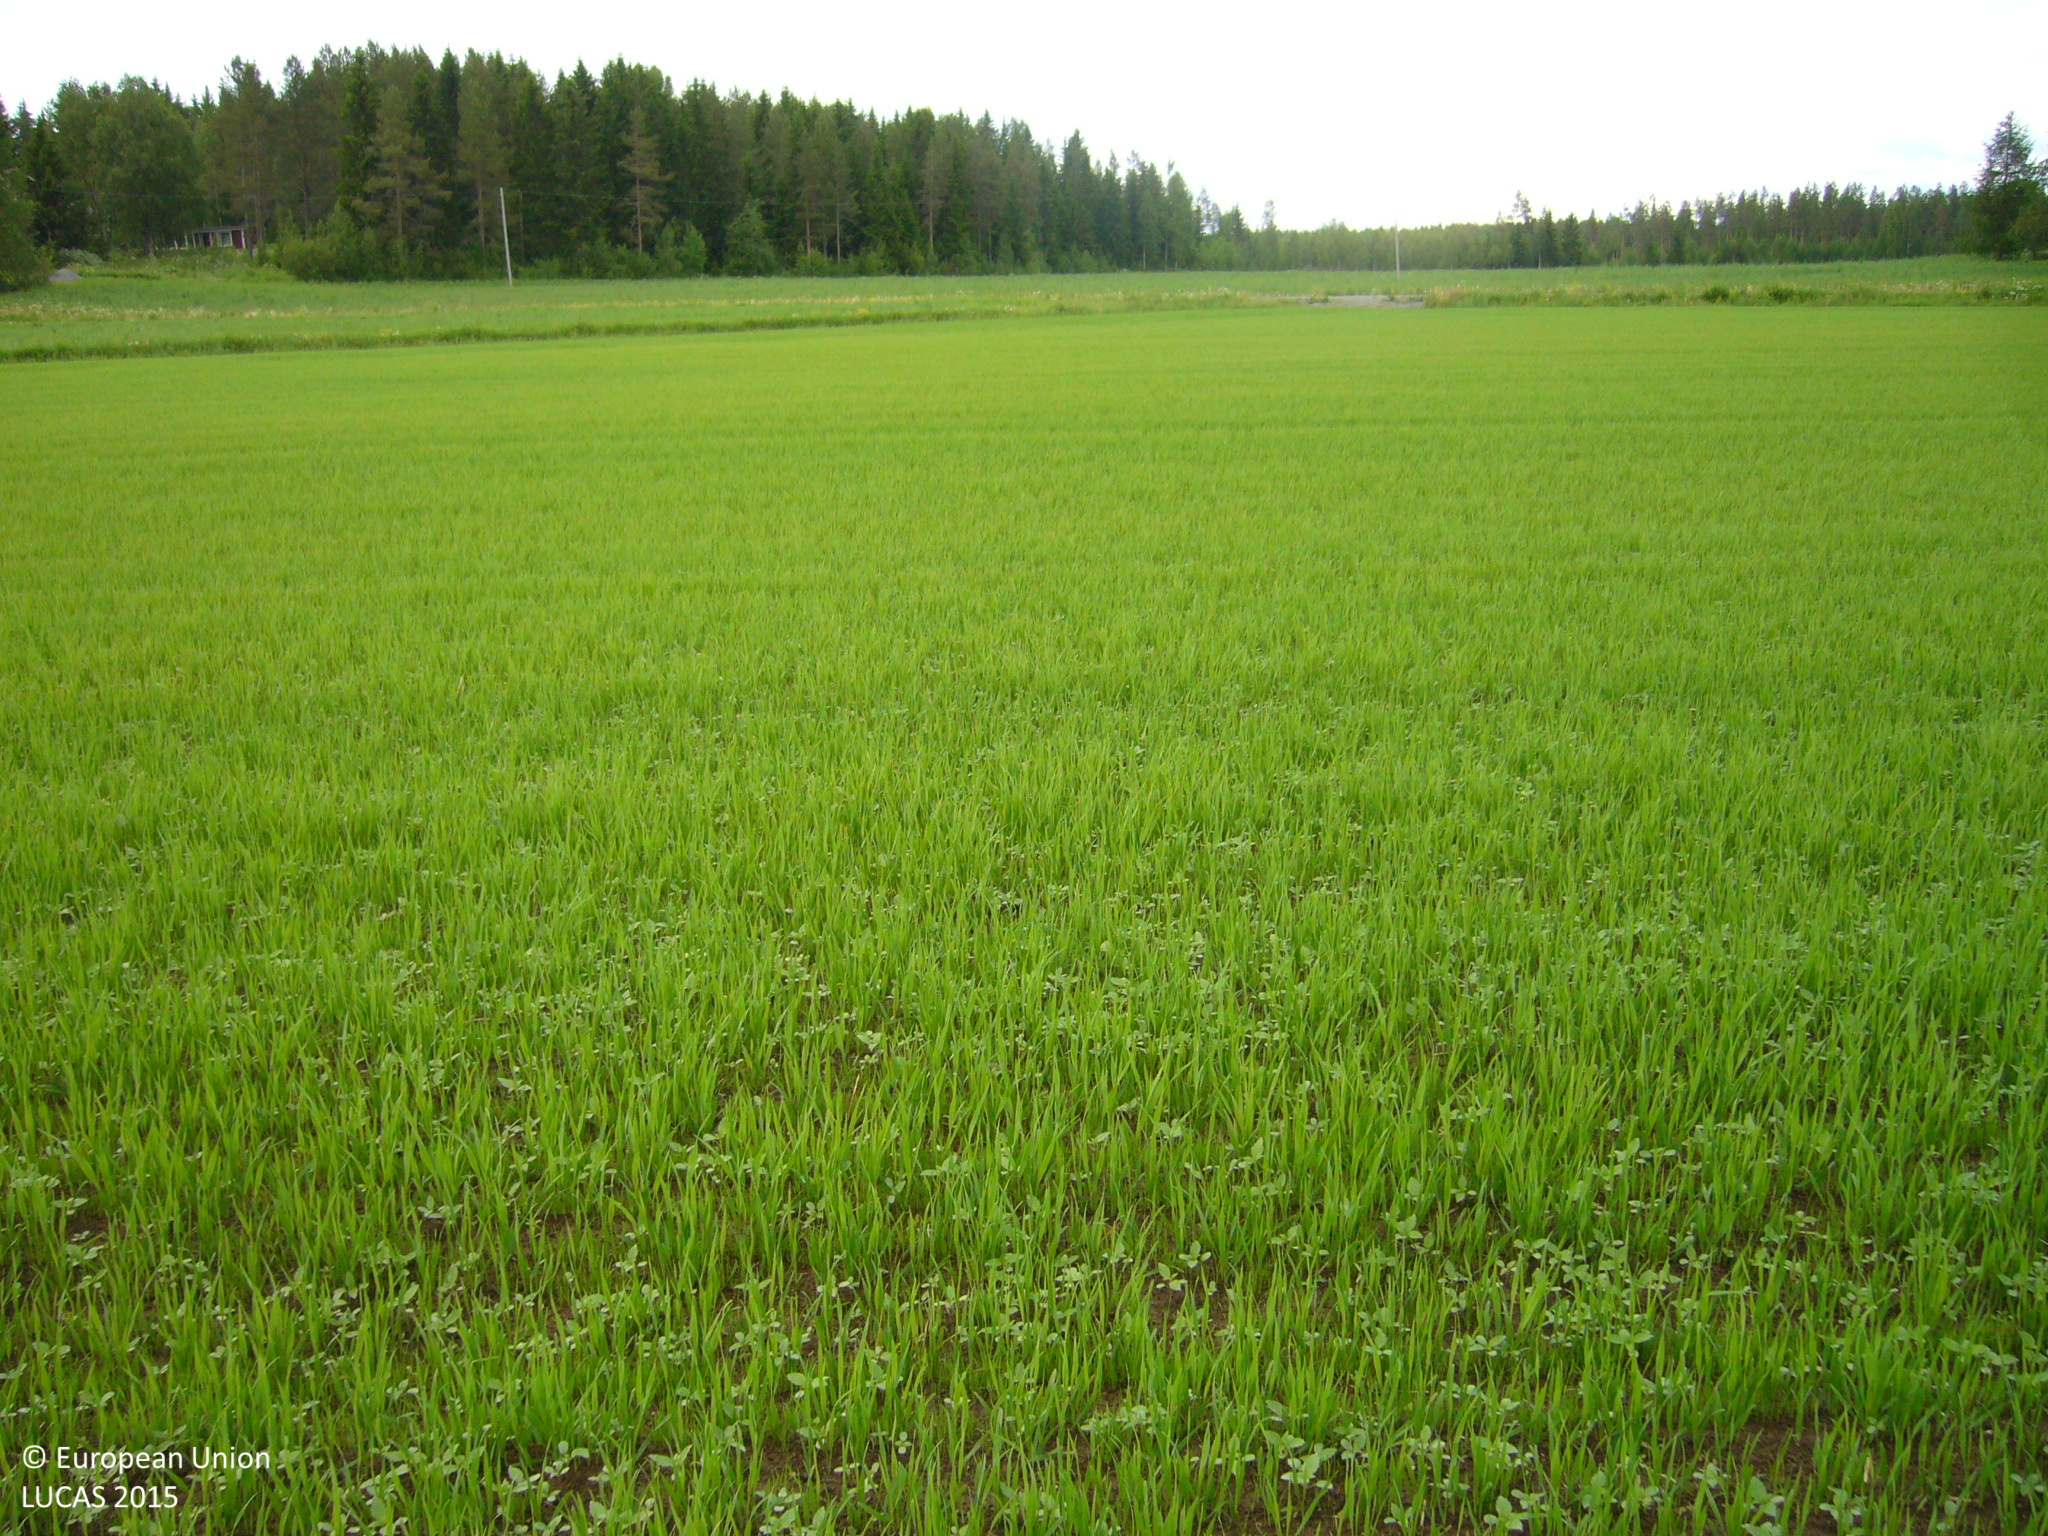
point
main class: Cropland
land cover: Barley
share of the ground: 50 - 75 %
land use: Agriculture (excluding fallow land and kitchen gardens)
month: June
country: FI
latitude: 63.7409
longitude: 26.3885
